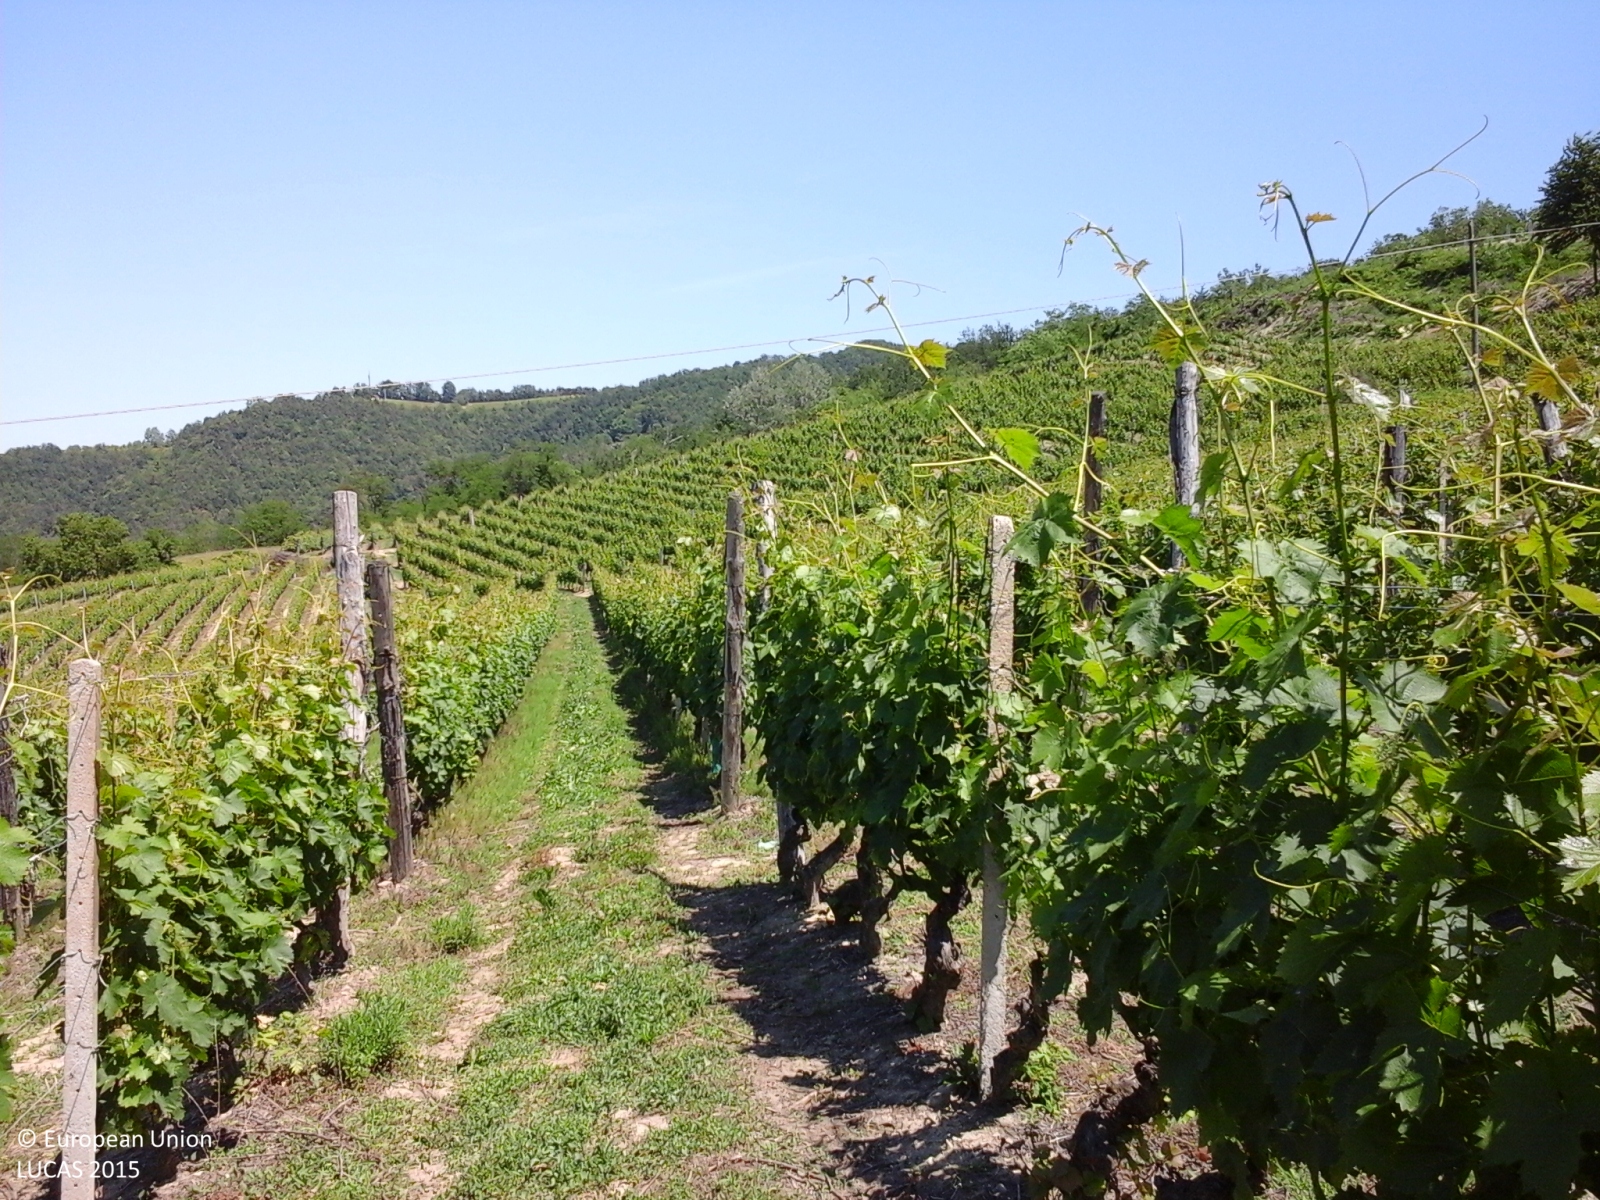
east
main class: Cropland
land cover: Vineyards
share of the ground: 50 - 75 %
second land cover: Grassland without tree/shrub cover
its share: > 75 %
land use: Agriculture (excluding fallow land and kitchen gardens)
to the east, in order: Vineyards; Grassland without tree/shrub cover; Electric lines; Vineyards; Tracks; Vineyards; Tracks; Vineyards; Tracks; Broadleaved woodland; Ditches and canals; Broadleaved woodland; Grassland without tree/shrub cover
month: June
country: IT
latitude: 44.6245
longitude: 8.2517
